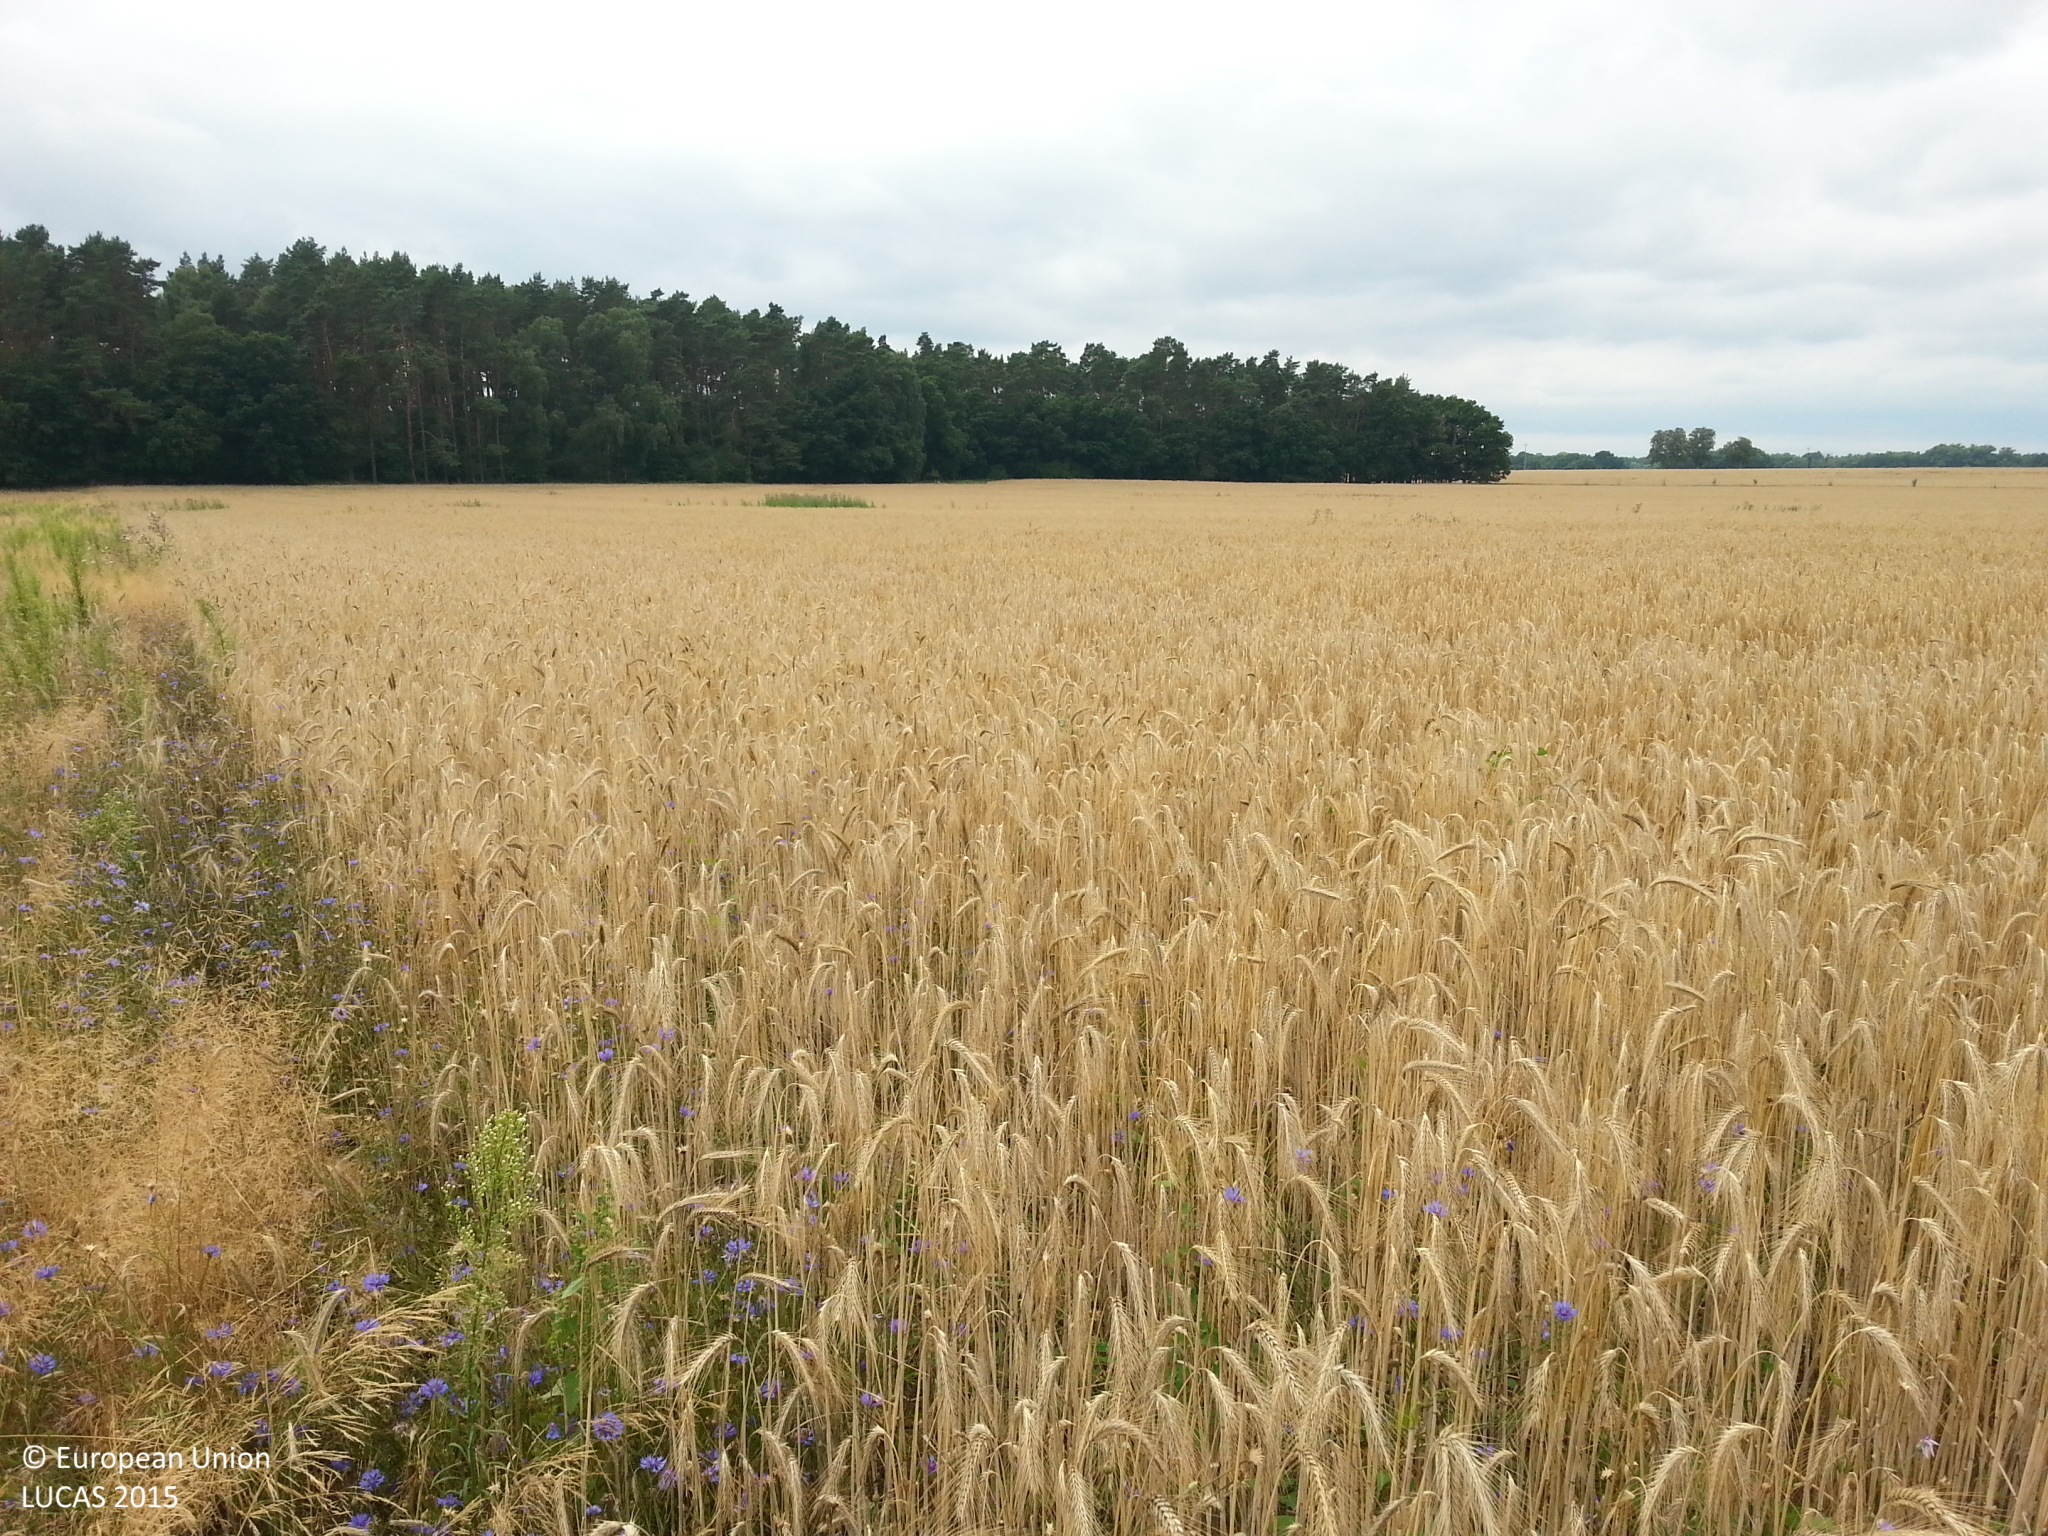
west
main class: Cropland
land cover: Rye
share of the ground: > 75 %
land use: Agriculture (excluding fallow land and kitchen gardens)
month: July
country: DE
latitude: 53.2874
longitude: 12.4444
